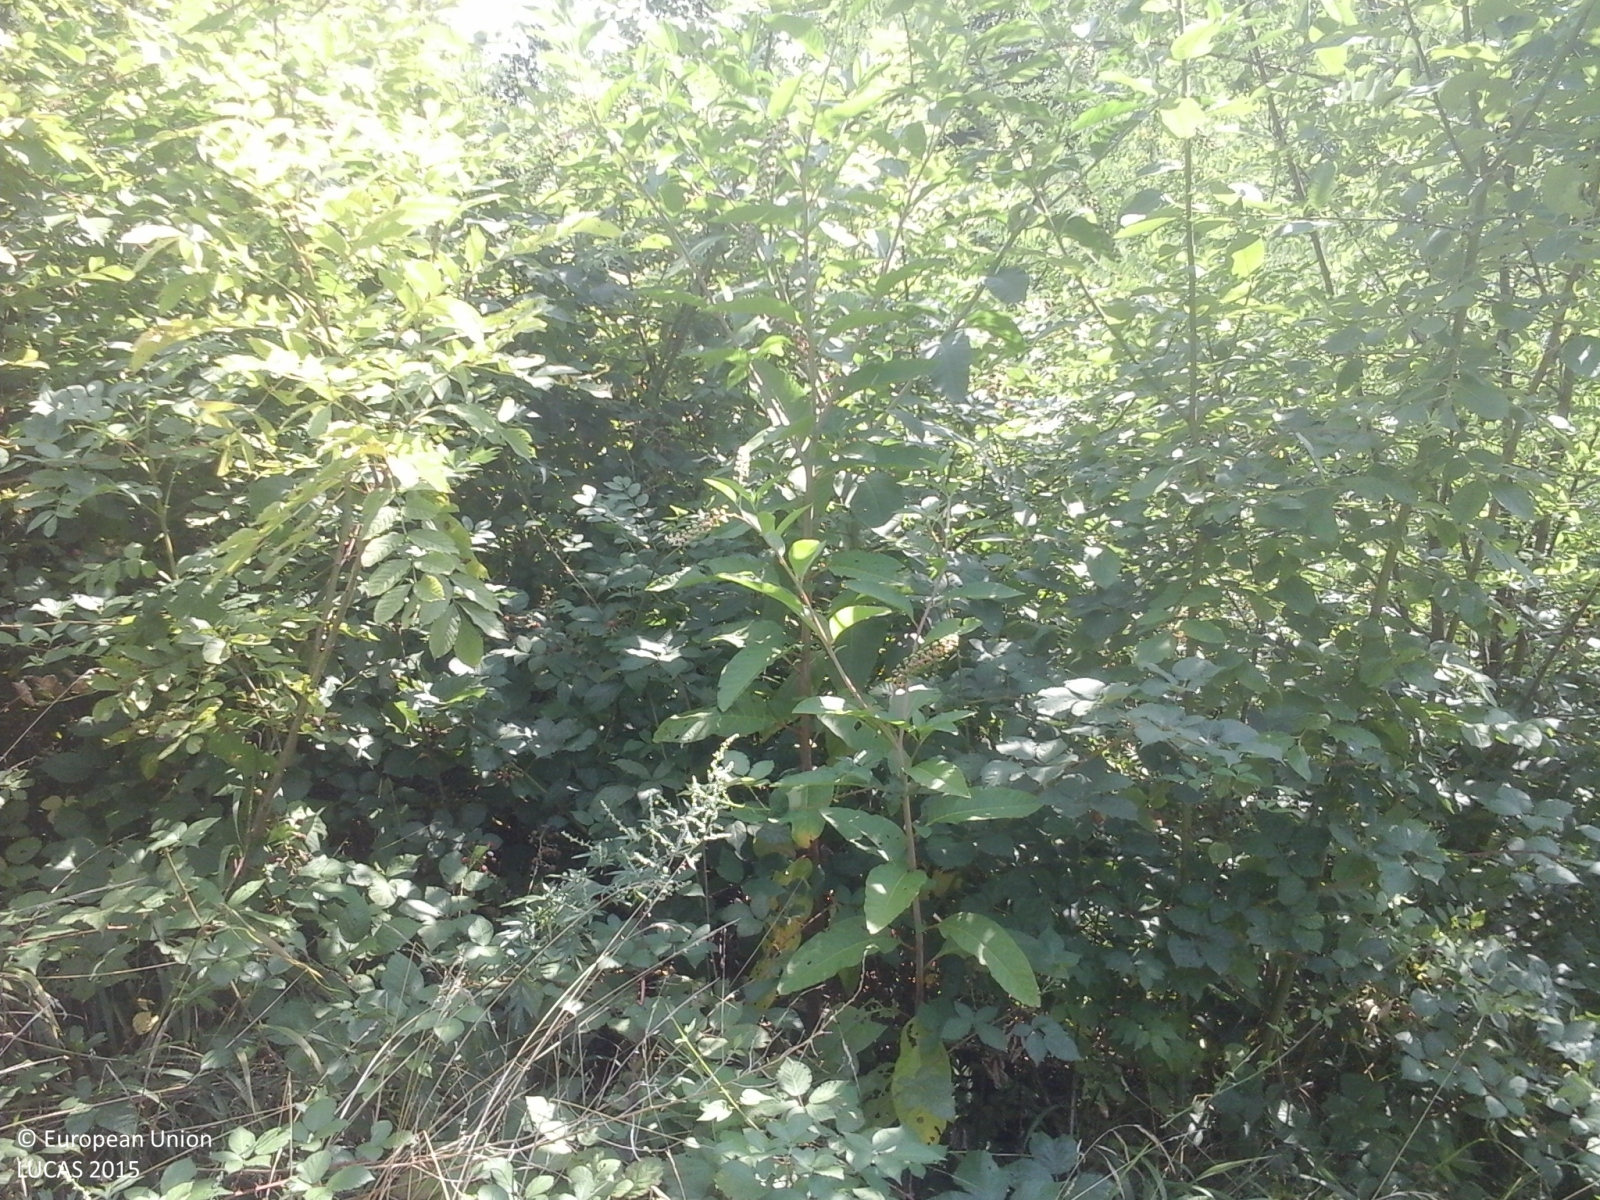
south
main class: Woodland
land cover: Broadleaved woodland
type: thermophilous deciduous forest
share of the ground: > 75 %
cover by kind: broadleaved forest trees 80 %, coniferous forest trees 10 %, shrubs 5 %, herbaceous plants 5 %
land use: Forestry
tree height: > 5 m
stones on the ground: > 50 %
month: August
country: IT
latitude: 46.0251
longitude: 9.3679
